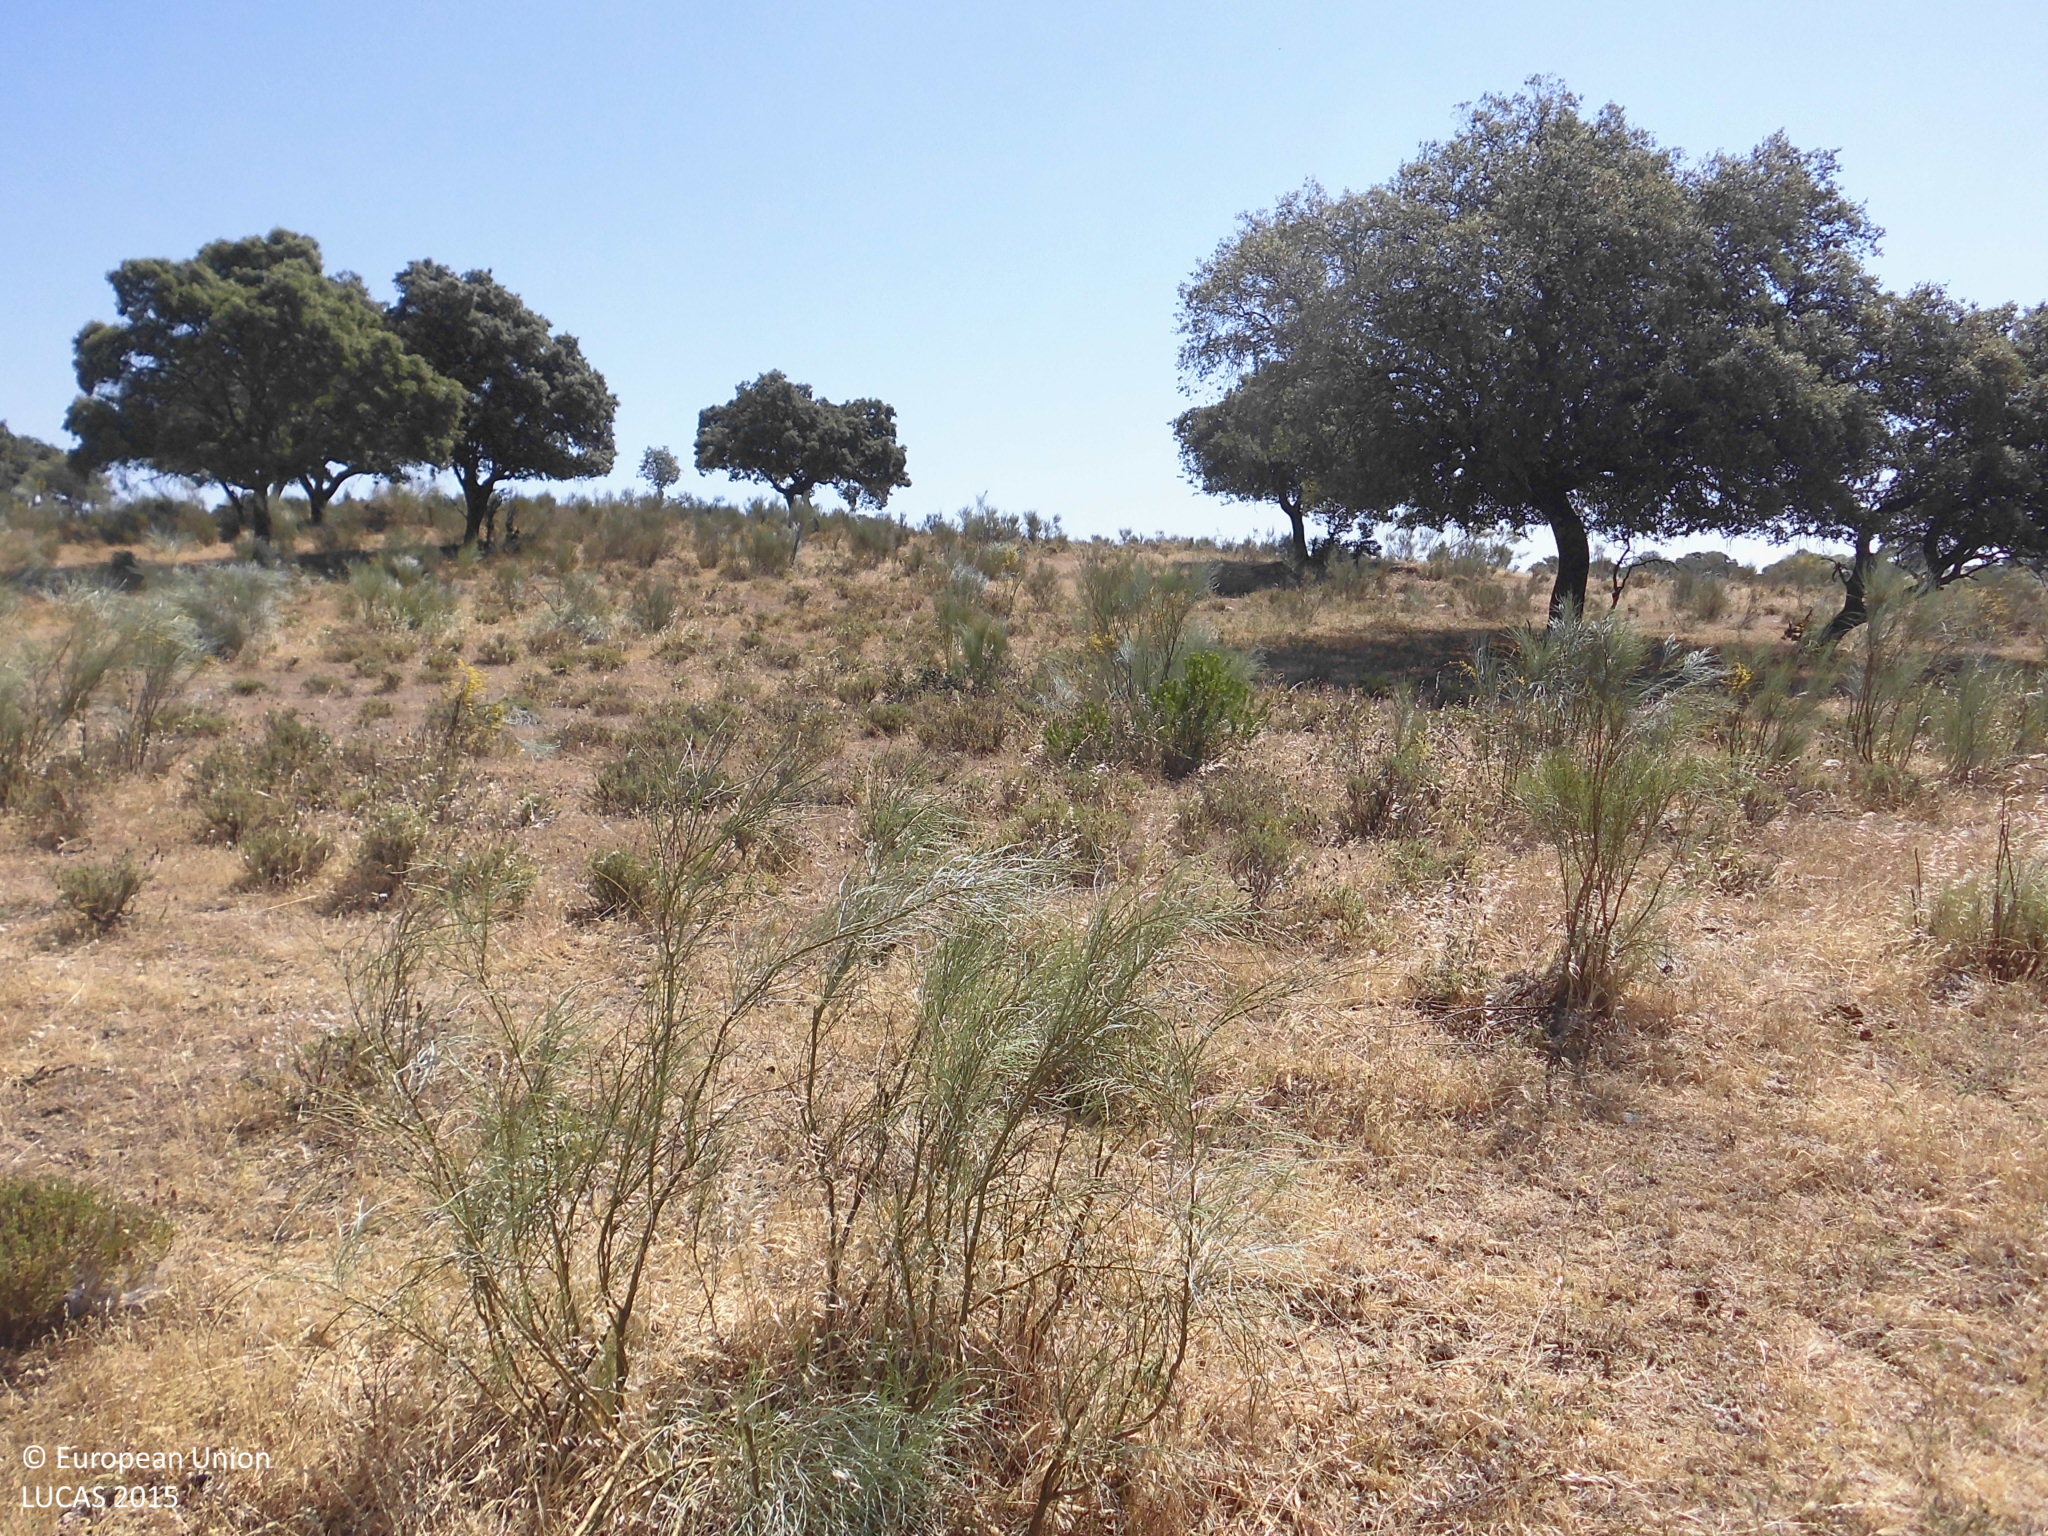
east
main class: Woodland
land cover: Broadleaved woodland
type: broadleaved evergreen forest
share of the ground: 10 - 25 %
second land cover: Grassland without tree/shrub cover
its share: > 75 %
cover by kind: herbaceous plants 85 %, broadleaved forest trees 15 %
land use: Forestry
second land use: Agriculture (excluding fallow land and kitchen gardens)
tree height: > 5 m
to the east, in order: Broadleaved woodland; Grassland without tree/shrub cover; Fences; Grass margins; Tracks; Grass margins; Dry stone walls; Single bushes/trees; Grassland with sparse tree/shrub cover; Dry stone walls; Shruby margins; Grassland with sparse tree/shrub cover; Tracks; Grassland with sparse tree/shrub cover
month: May
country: ES
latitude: 39.6876
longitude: -6.7181
